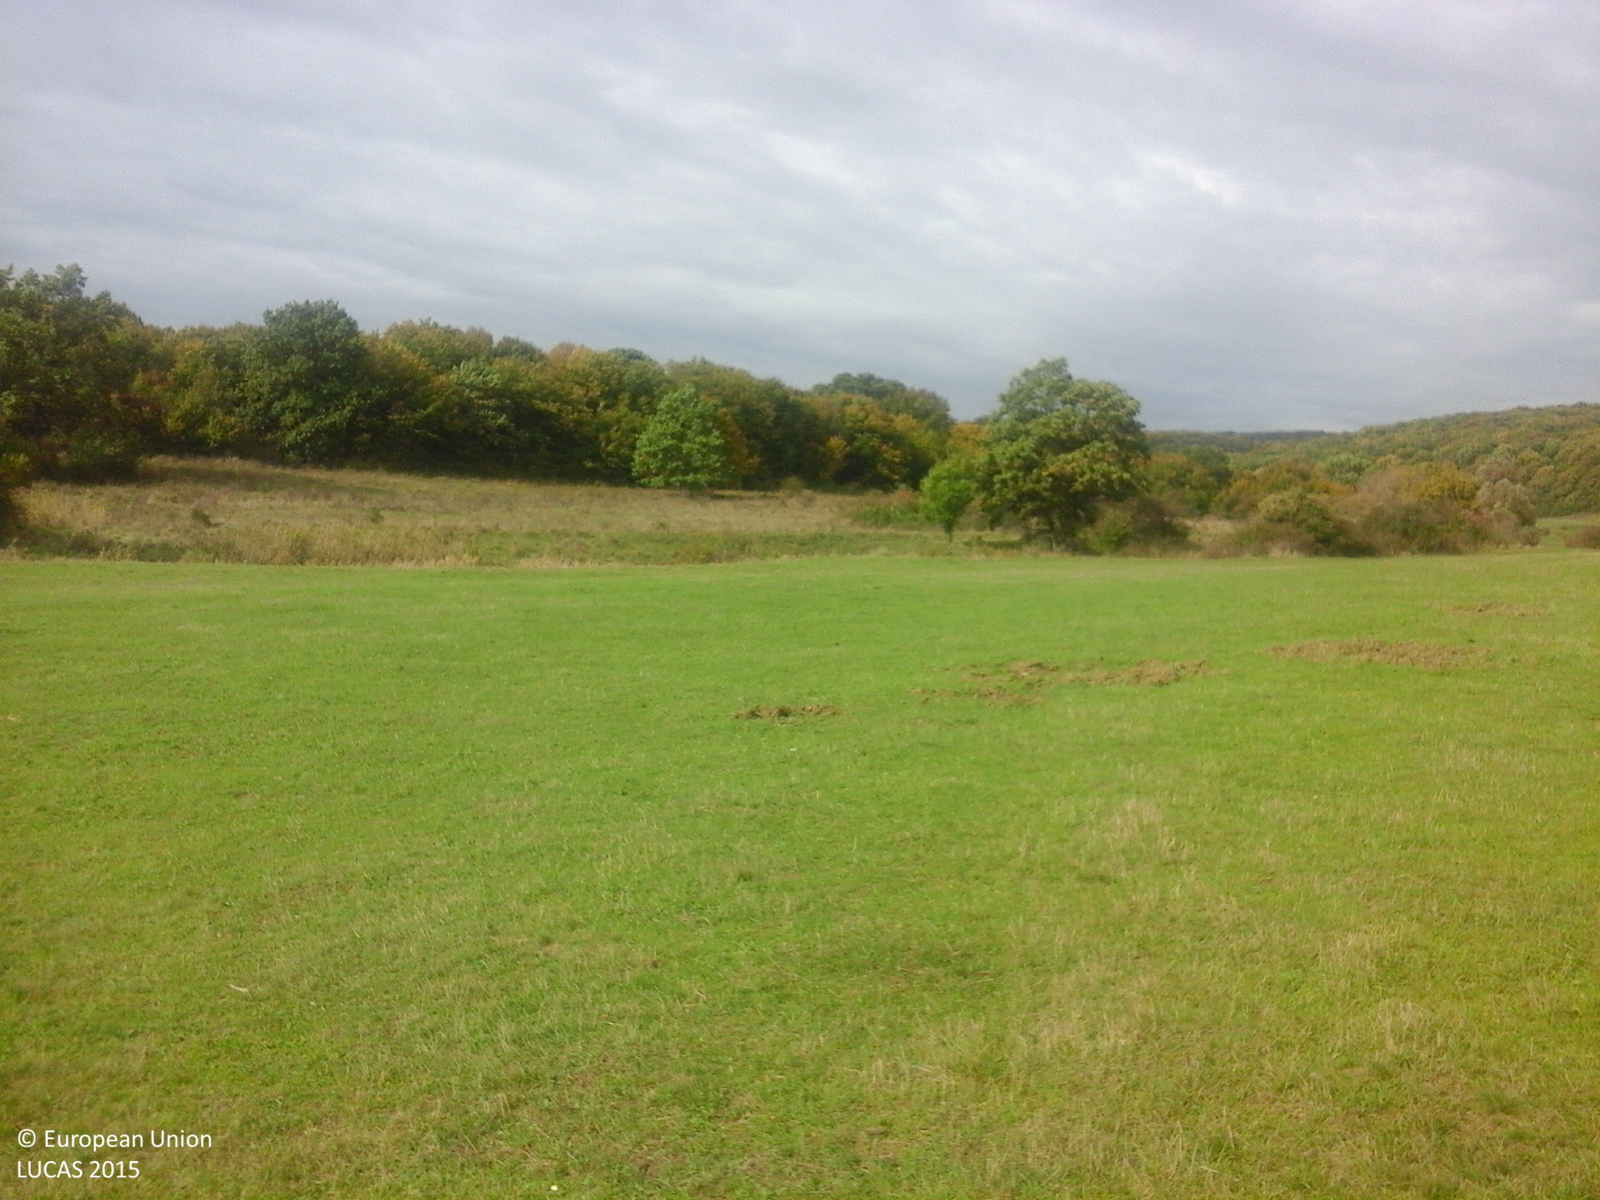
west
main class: Grassland
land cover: Grassland without tree/shrub cover
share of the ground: > 75 %
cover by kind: herbaceous plants 100 %
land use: Agriculture (excluding fallow land and kitchen gardens)
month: October
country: RO
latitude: 46.2130
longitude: 25.1743
